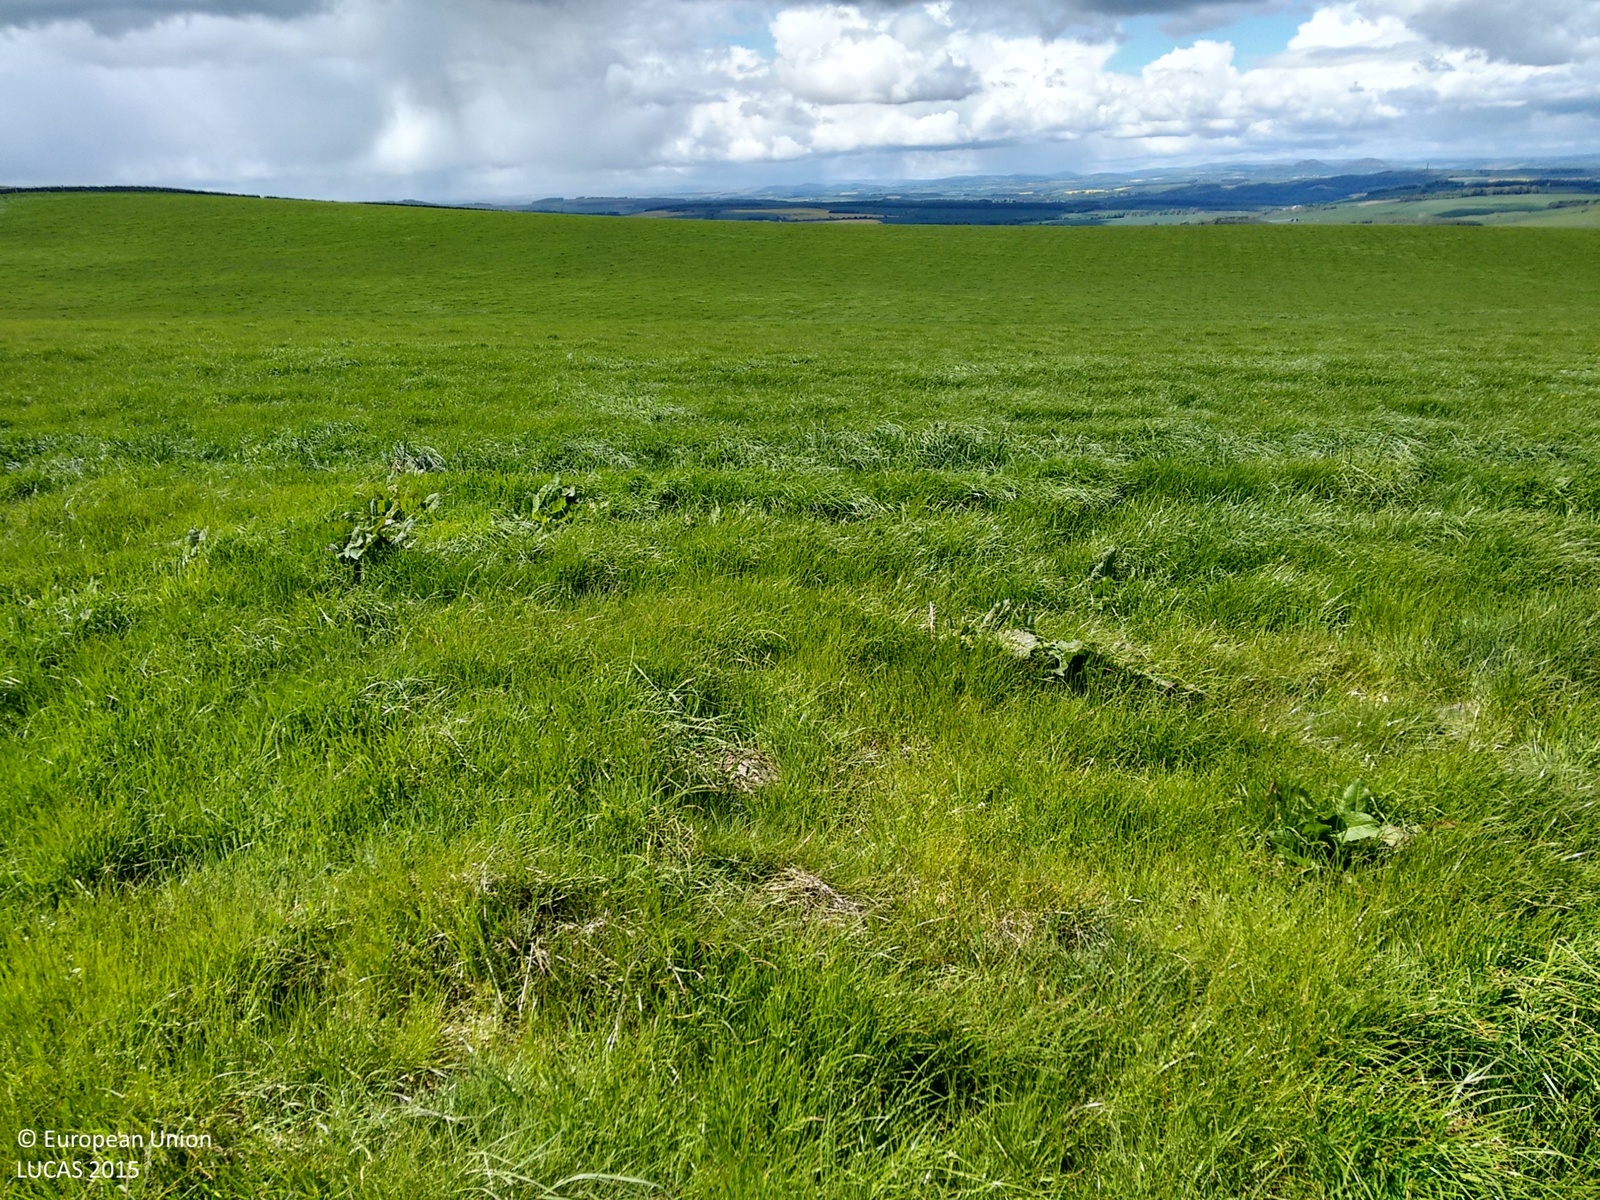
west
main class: Grassland
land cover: Grassland without tree/shrub cover
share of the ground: > 75 %
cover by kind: herbaceous plants 100 %
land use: Agriculture (excluding fallow land and kitchen gardens)
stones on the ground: < 10 %
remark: Harvested field
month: May
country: GB
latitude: 55.4727
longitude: -2.4149
